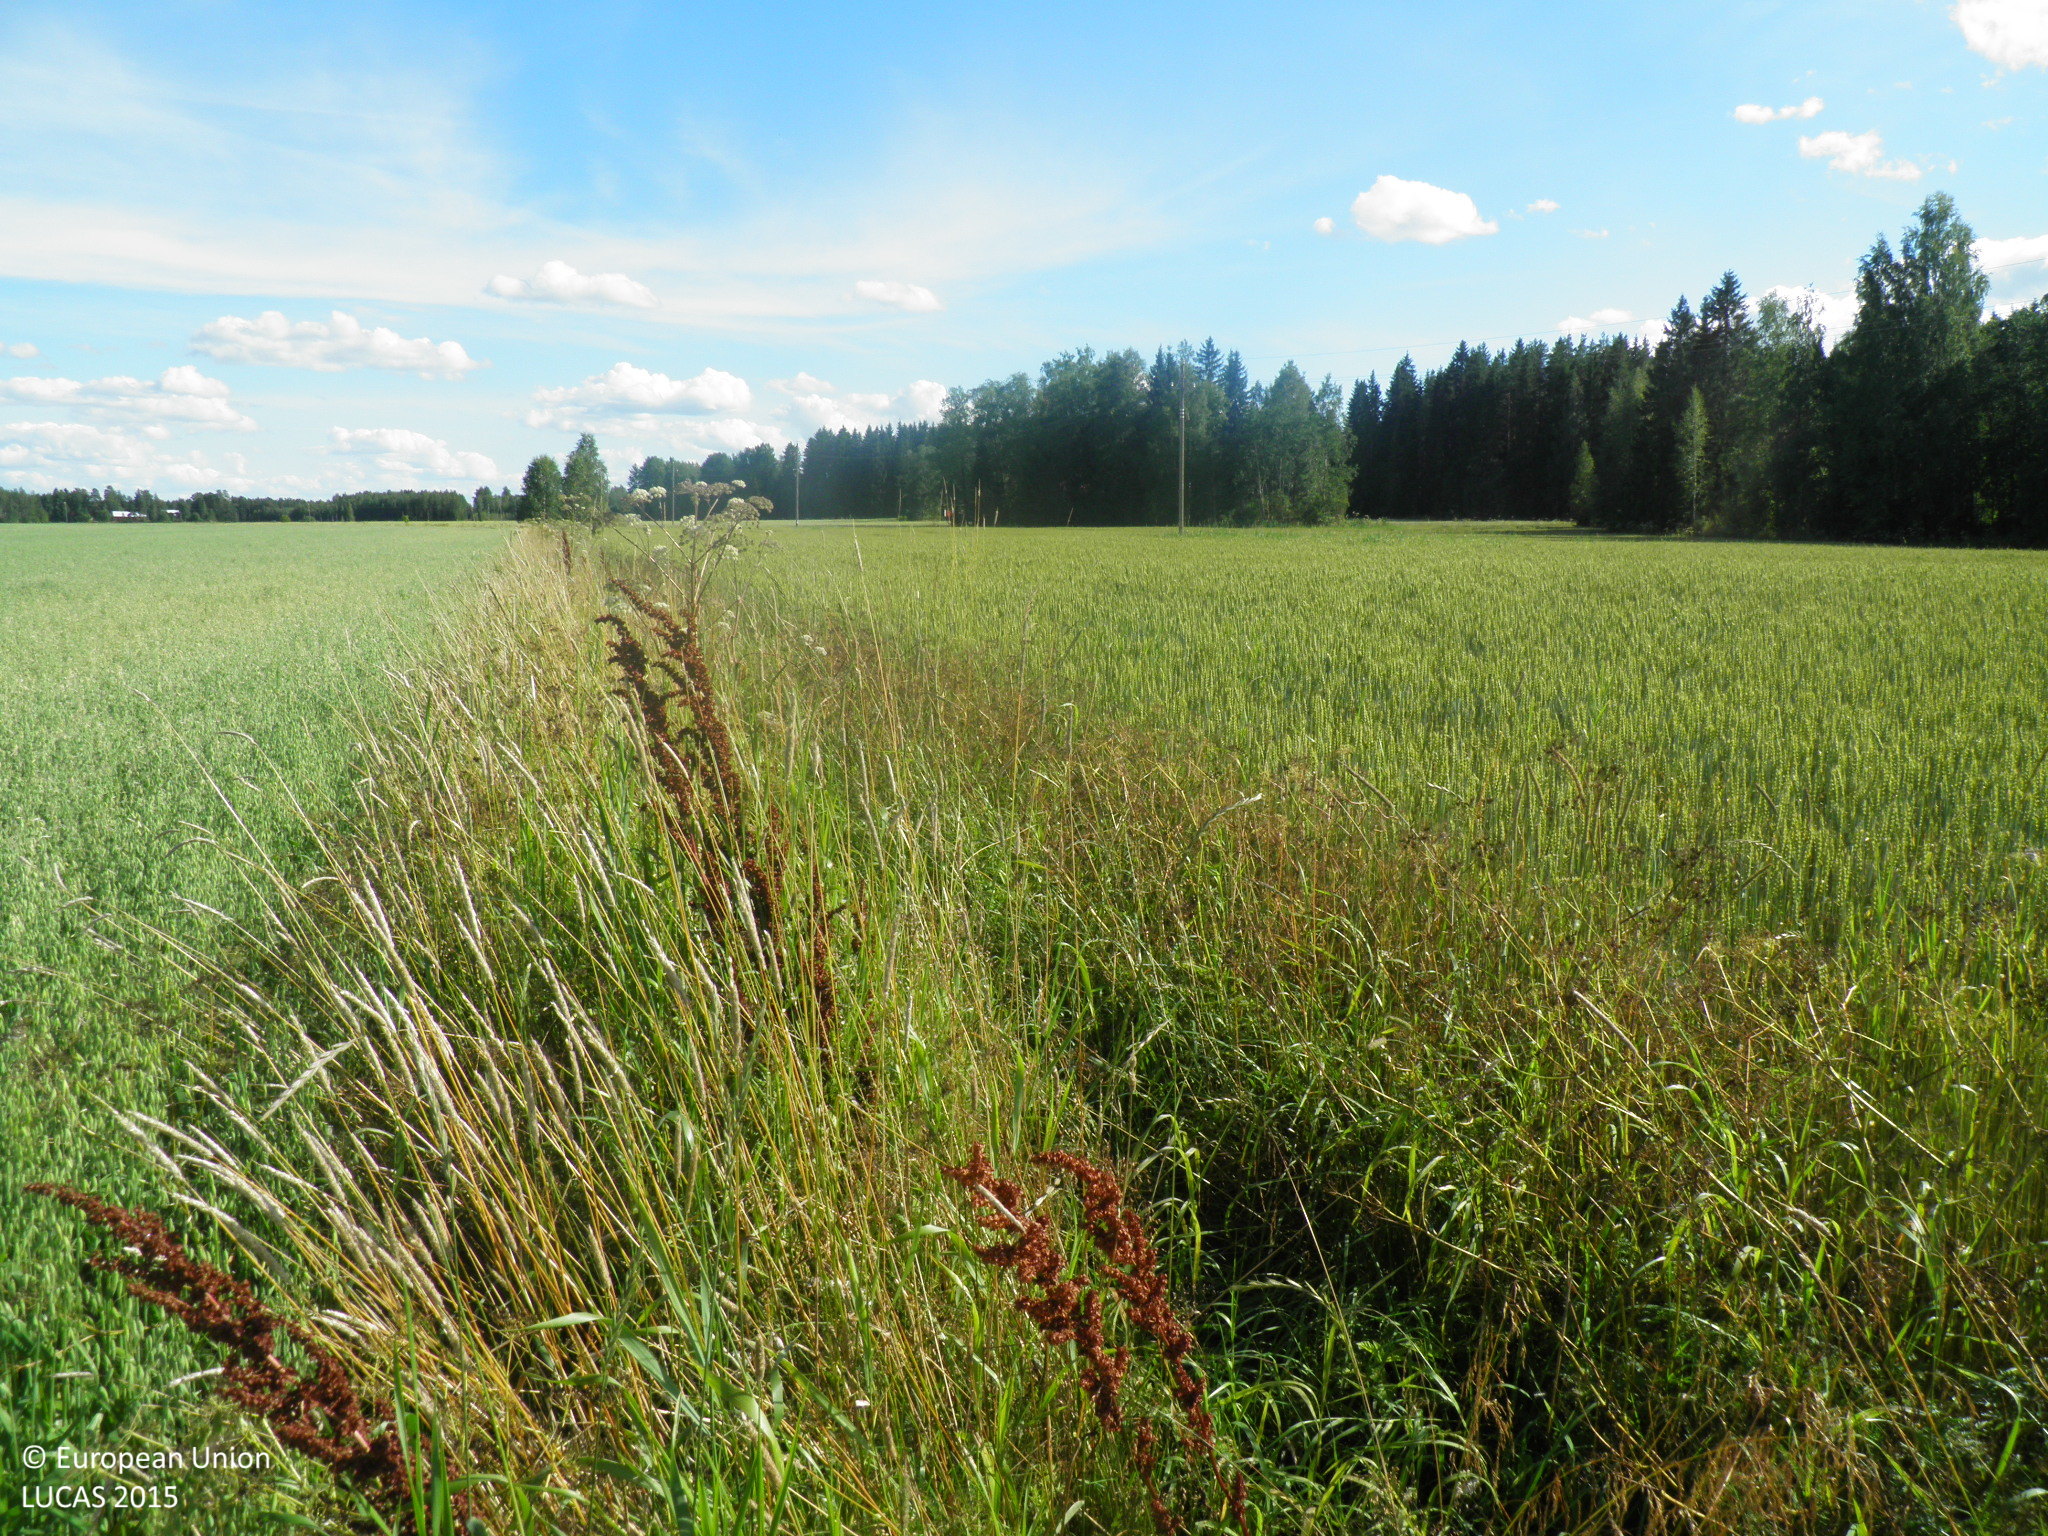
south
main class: Cropland
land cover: Oats
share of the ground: > 75 %
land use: Agriculture (excluding fallow land and kitchen gardens)
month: August
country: FI
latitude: 61.1471
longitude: 22.6068
